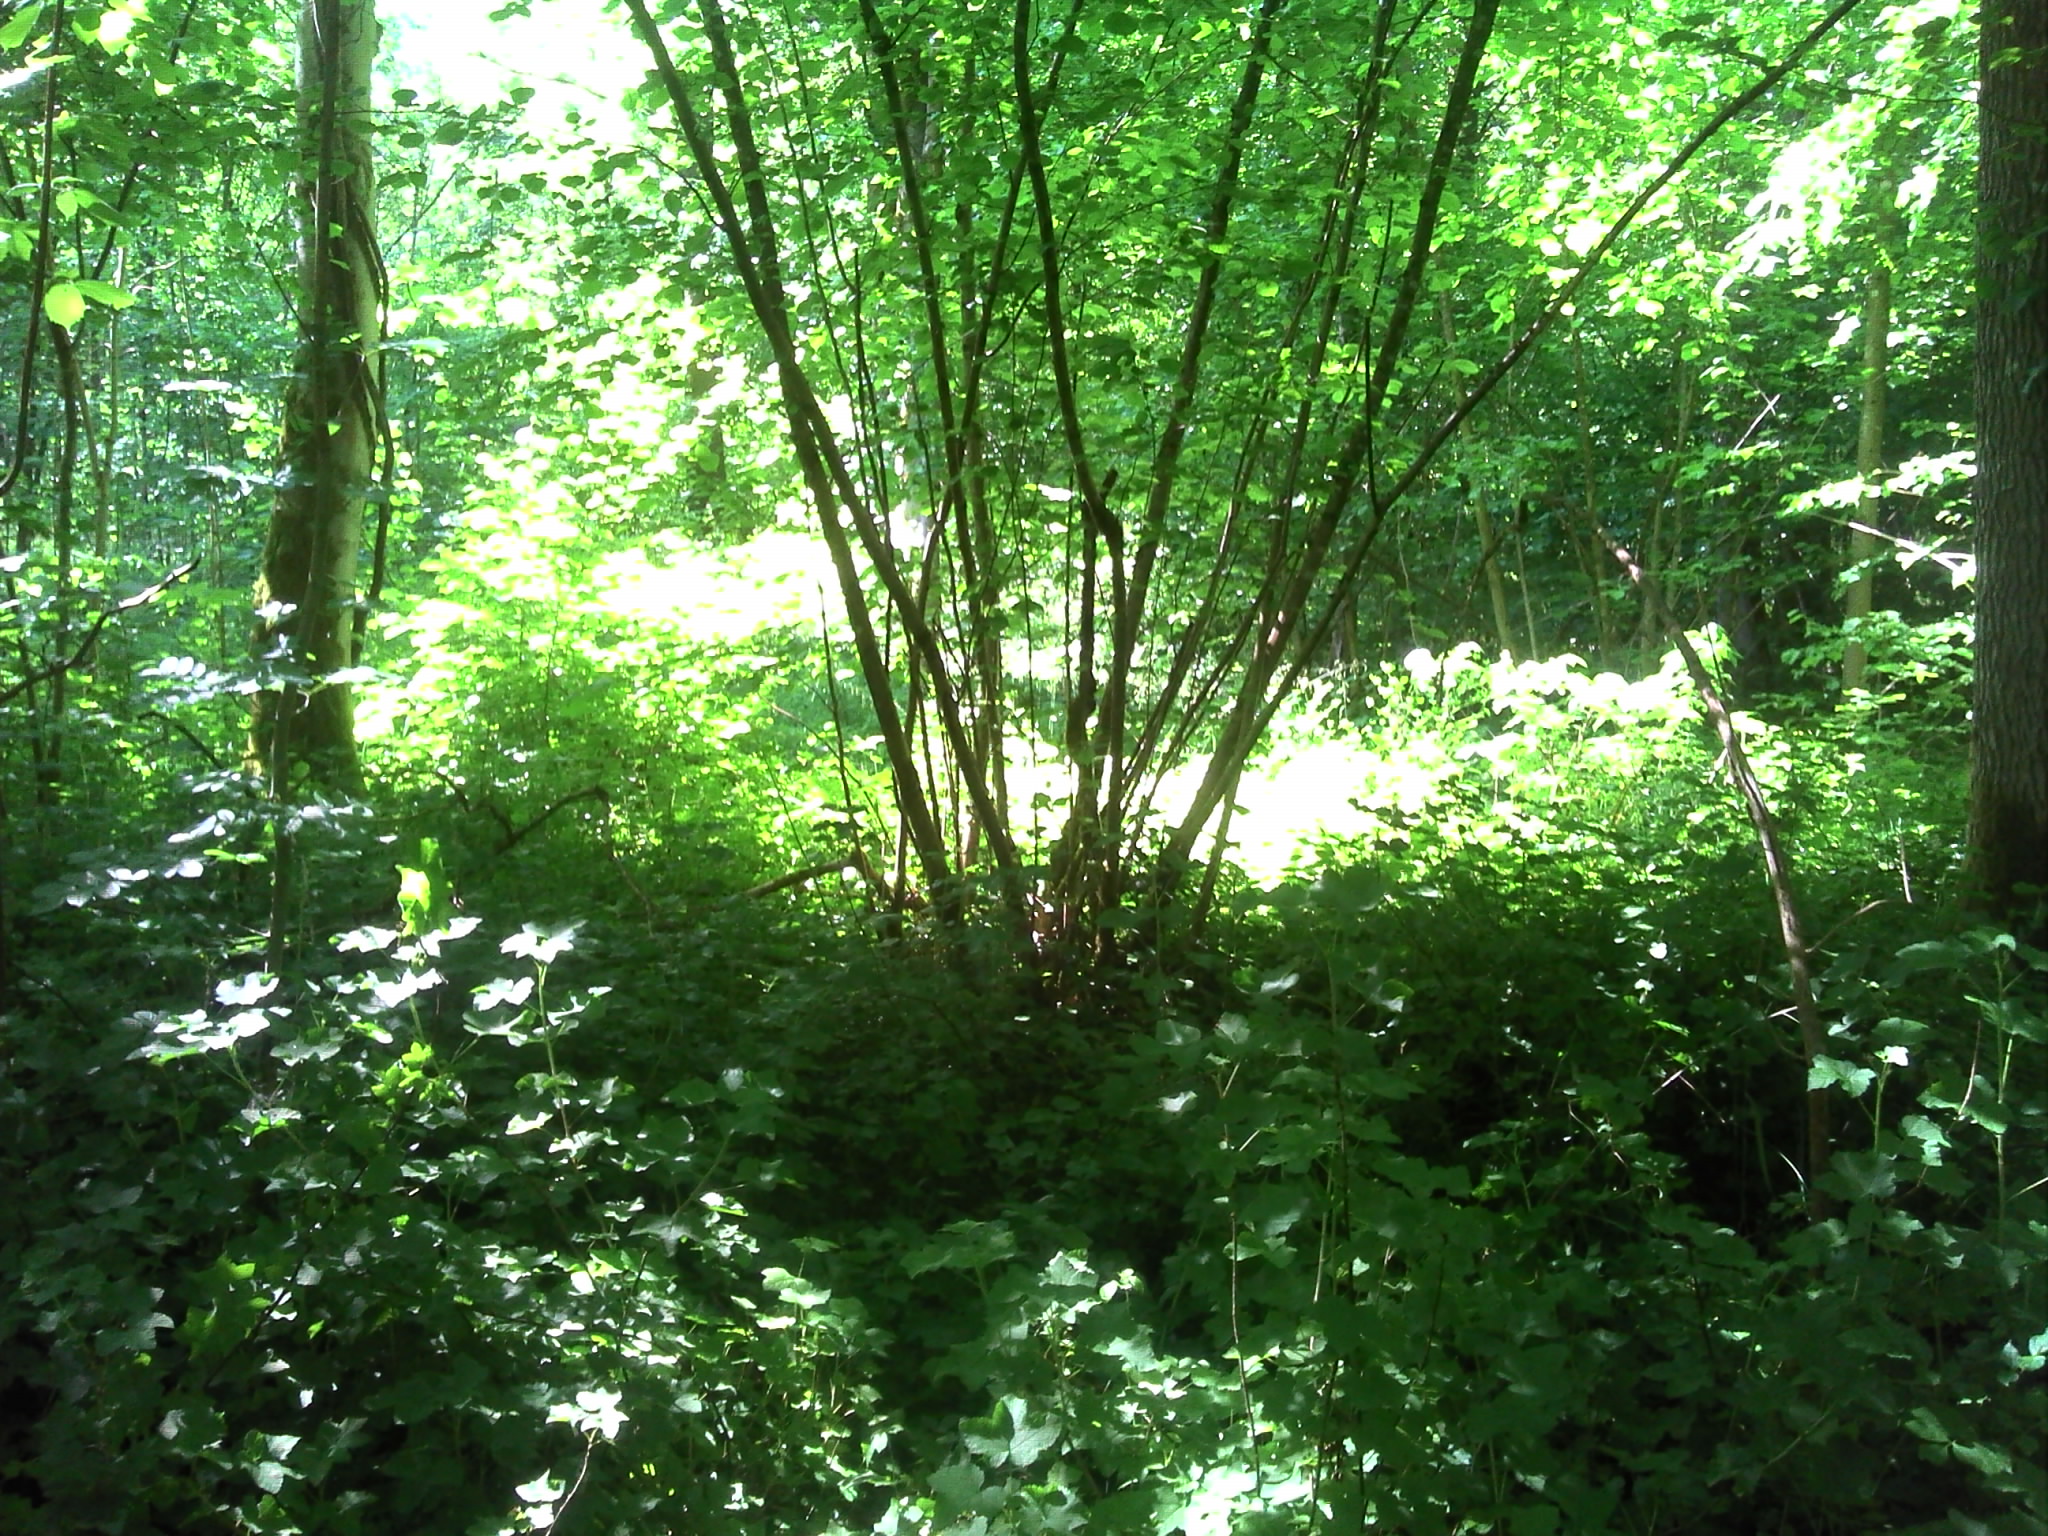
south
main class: Woodland
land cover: Broadleaved woodland
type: mesophytic deciduous forest
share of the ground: > 75 %
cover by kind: broadleaved forest trees 100 %
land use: Forestry
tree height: > 5 m
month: June
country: BE
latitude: 50.2998
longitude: 5.2104
